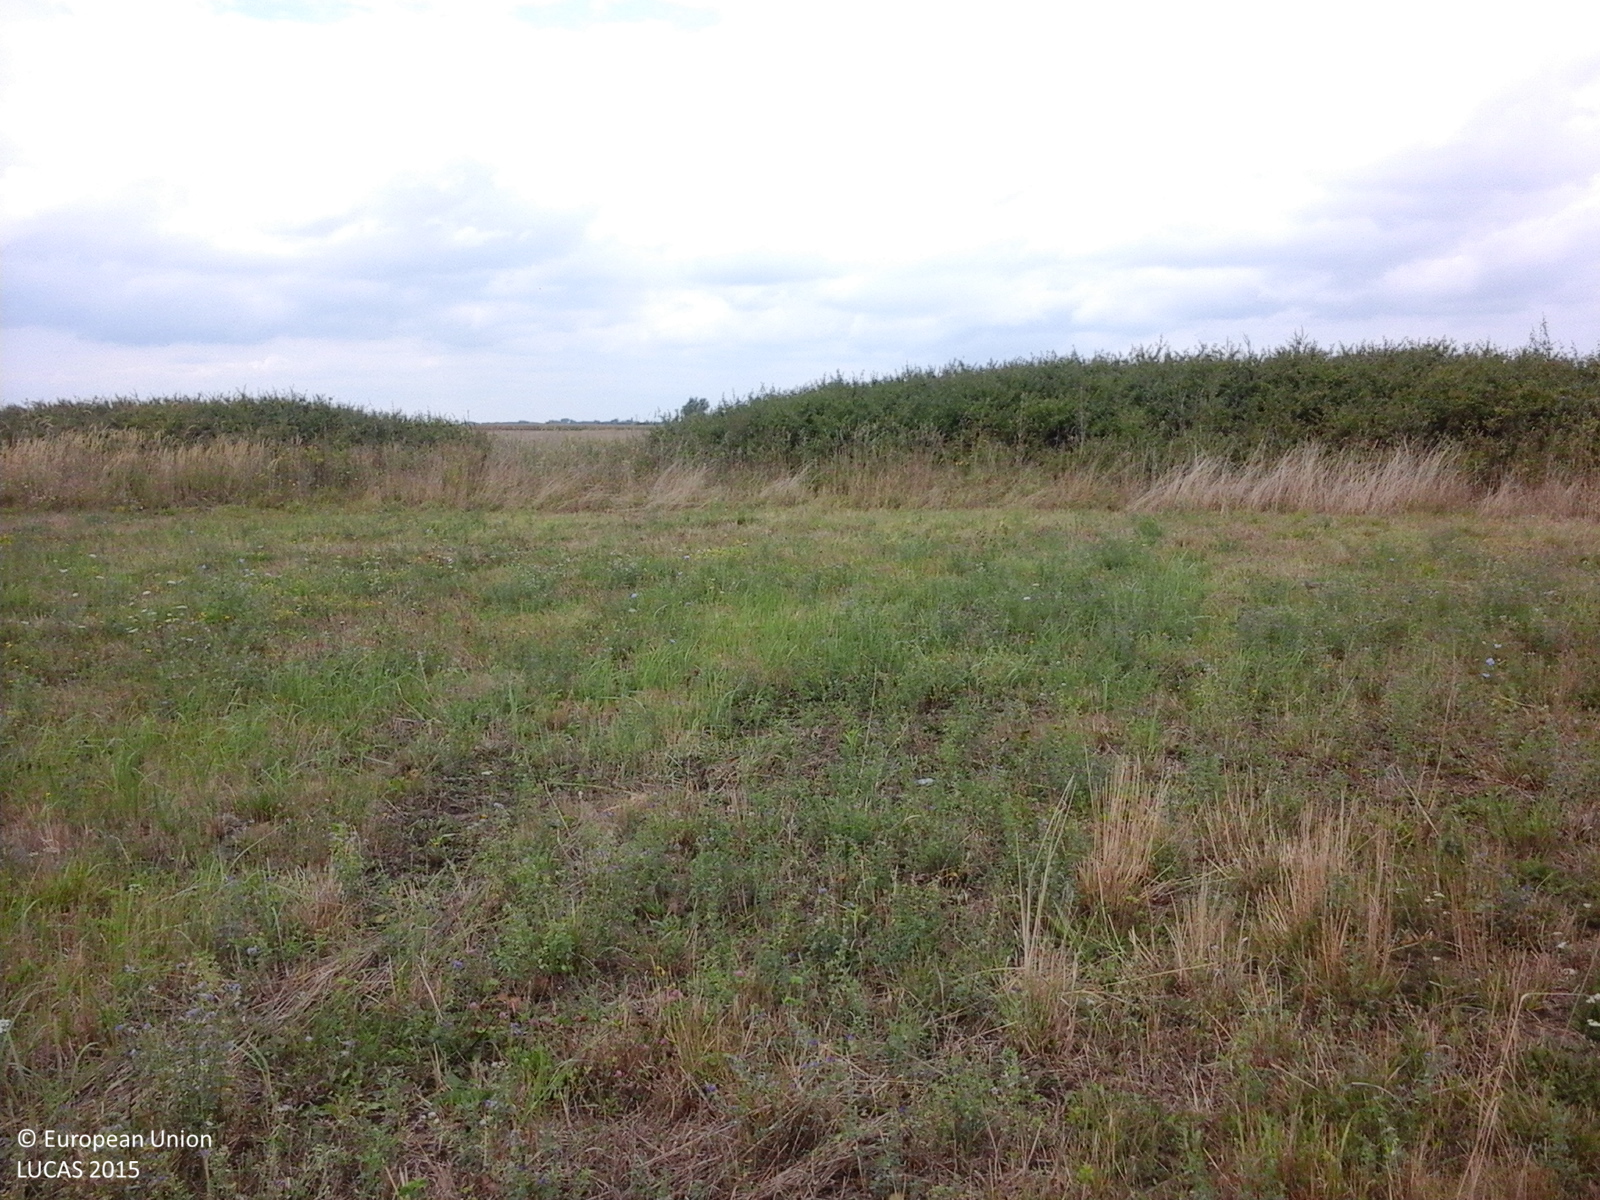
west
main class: Cropland
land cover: Other leguminous and mixtures for fodder
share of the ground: > 75 %
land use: Agriculture (excluding fallow land and kitchen gardens)
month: August
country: RO
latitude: 45.3159
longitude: 21.1119
